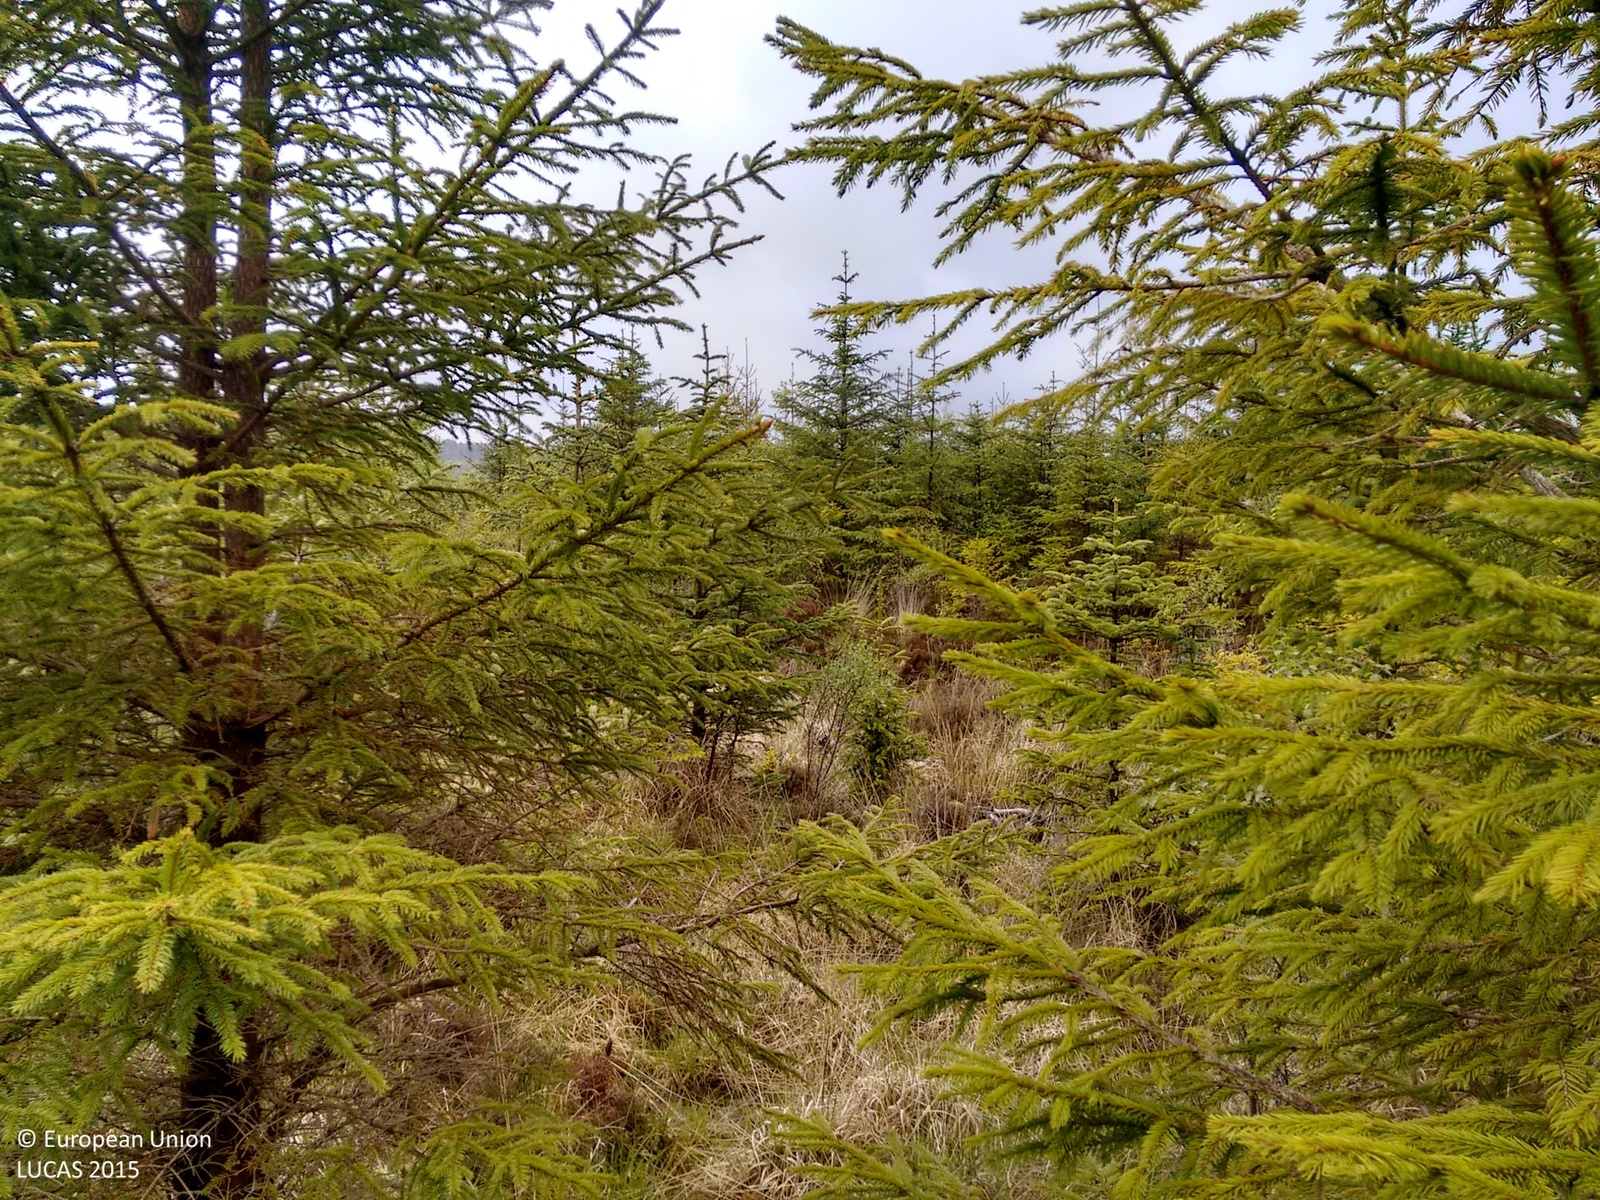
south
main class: Woodland
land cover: Other mixed woodland
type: exotic forest
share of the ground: > 75 %
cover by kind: coniferous forest trees 60 %, broadleaved forest trees 40 %
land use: Forestry
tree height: < 5 m
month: June
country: GB
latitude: 56.0680
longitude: -5.4613
